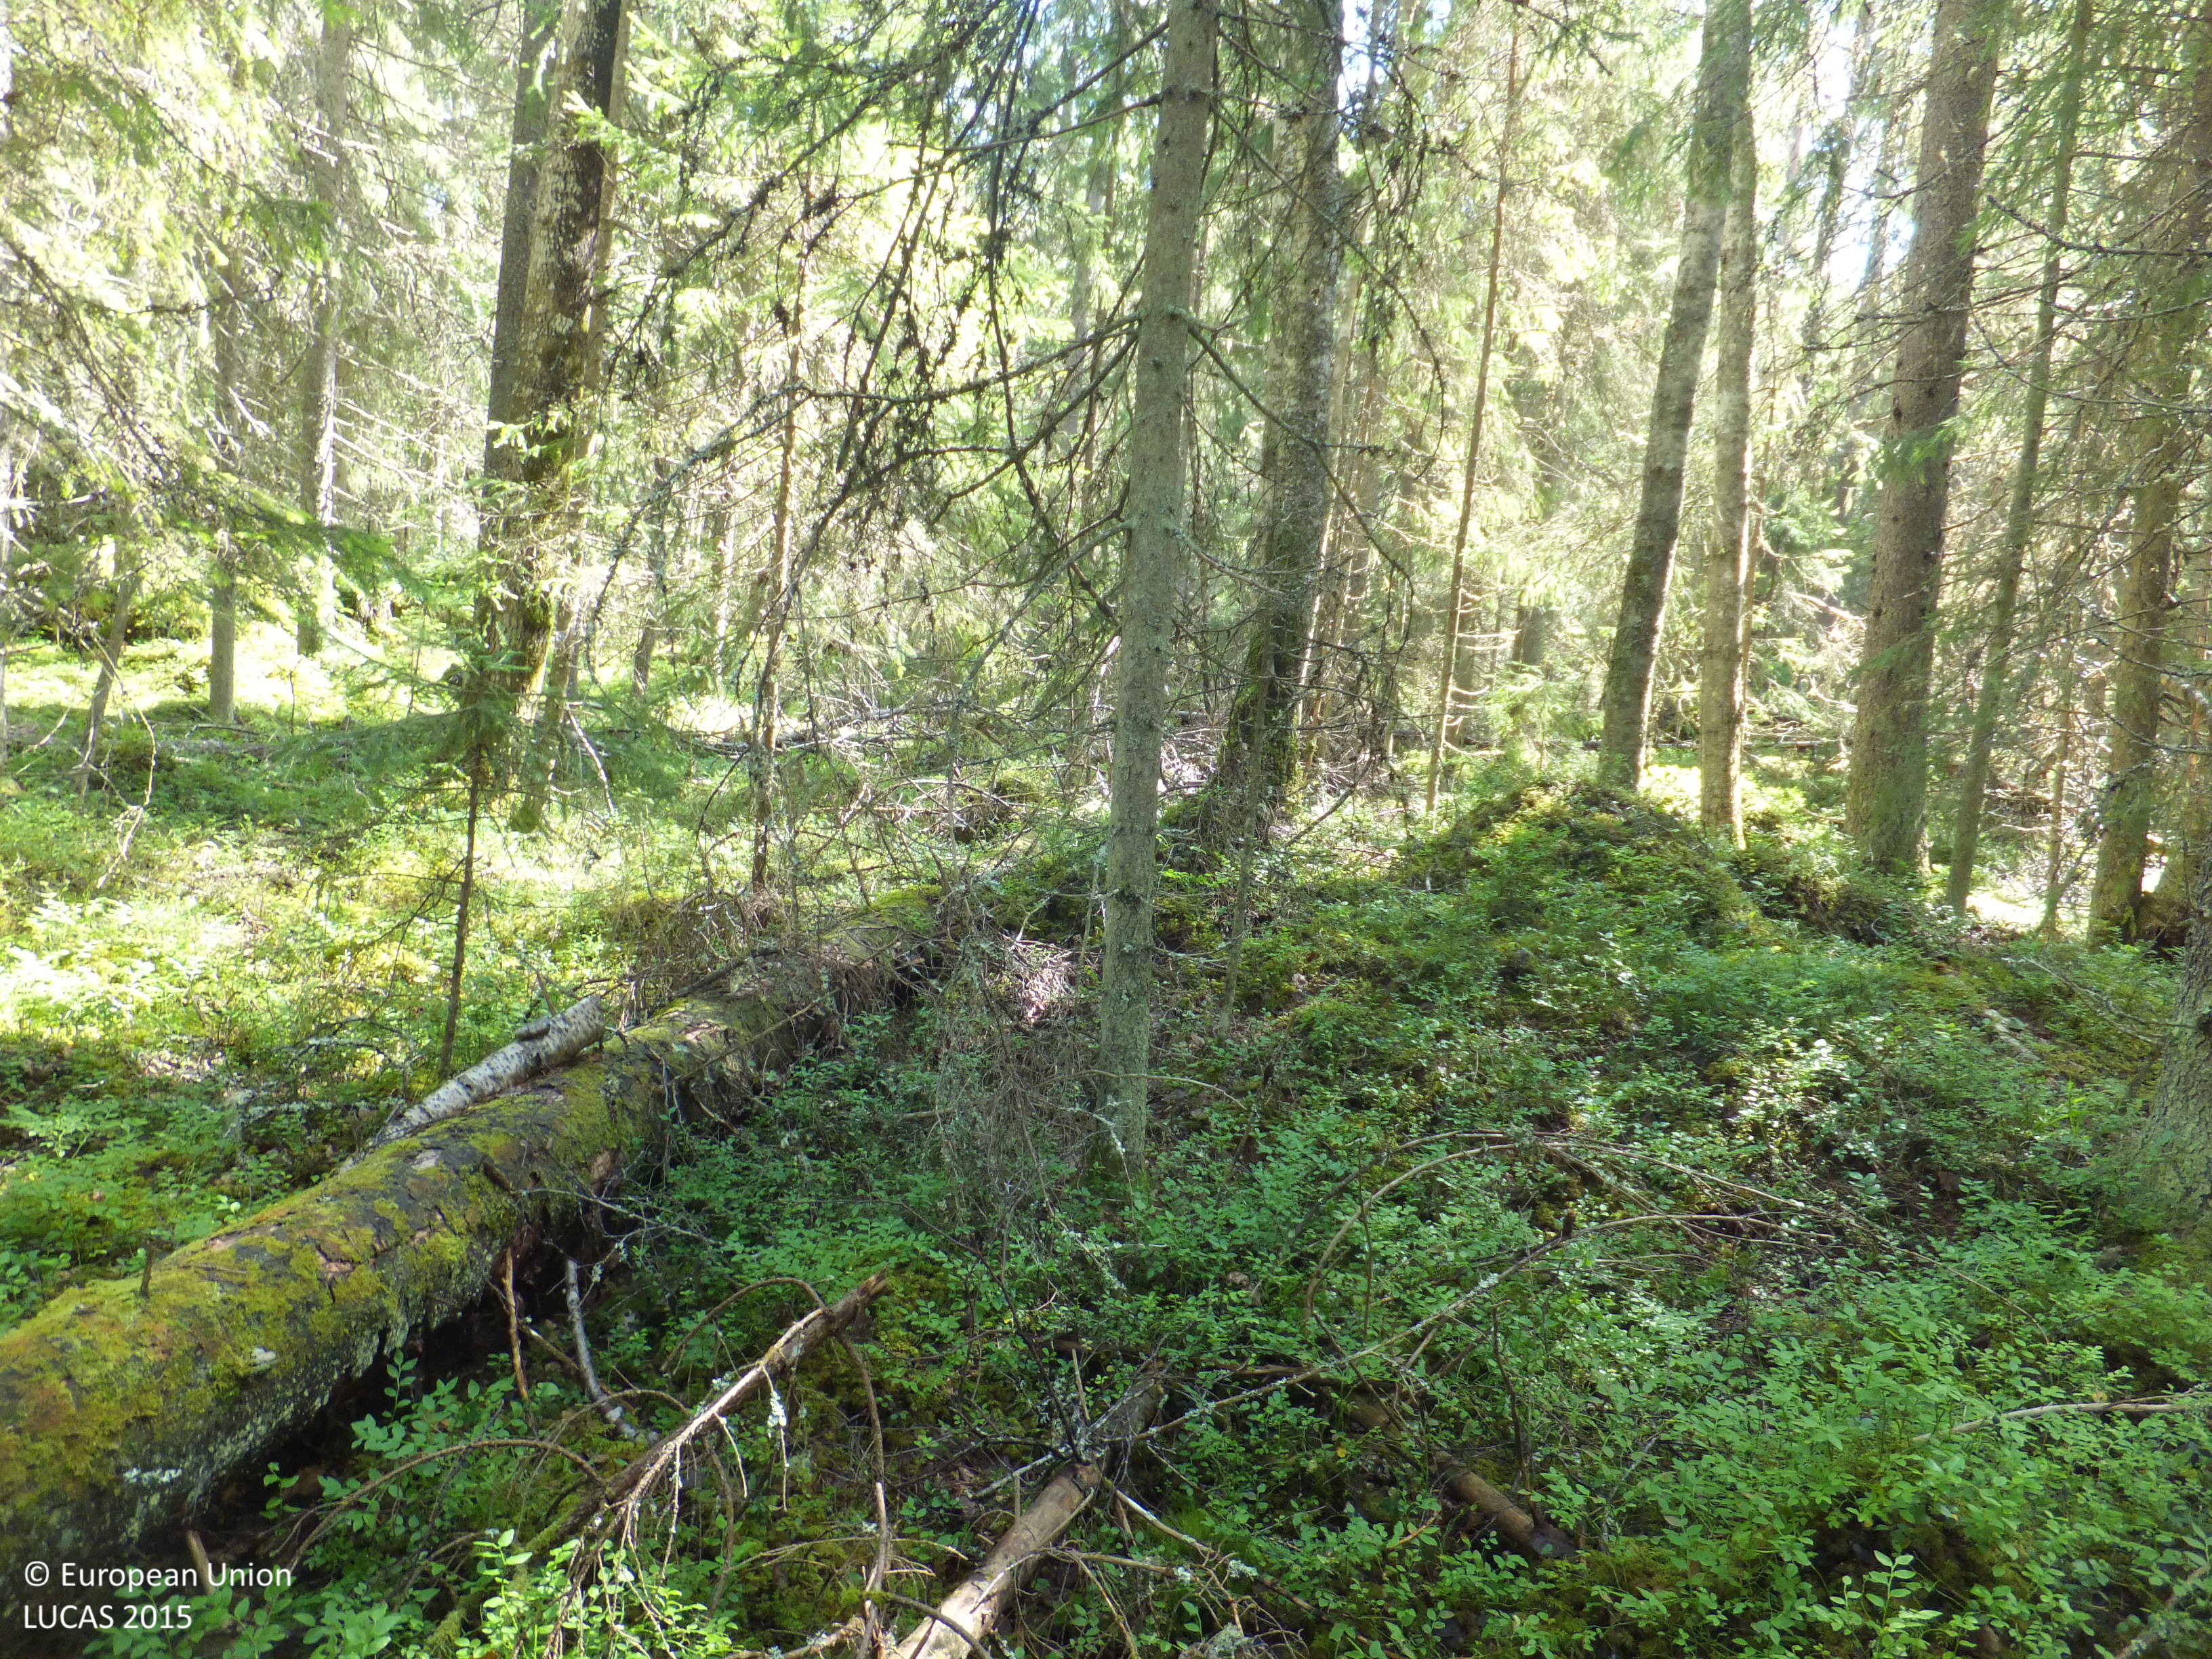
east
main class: Woodland
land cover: Spruce dominated mixed woodland
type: boreal forest
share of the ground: > 75 %
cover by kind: coniferous forest trees 50 %, broadleaved forest trees 30 %, shrubs 10 %, lichens and mosses 10 %
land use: Forestry
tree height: > 5 m
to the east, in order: Spruce dominated mixed woodland; Shrubland with sparse tree cover
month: August
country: FI
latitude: 63.0994
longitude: 22.2310
